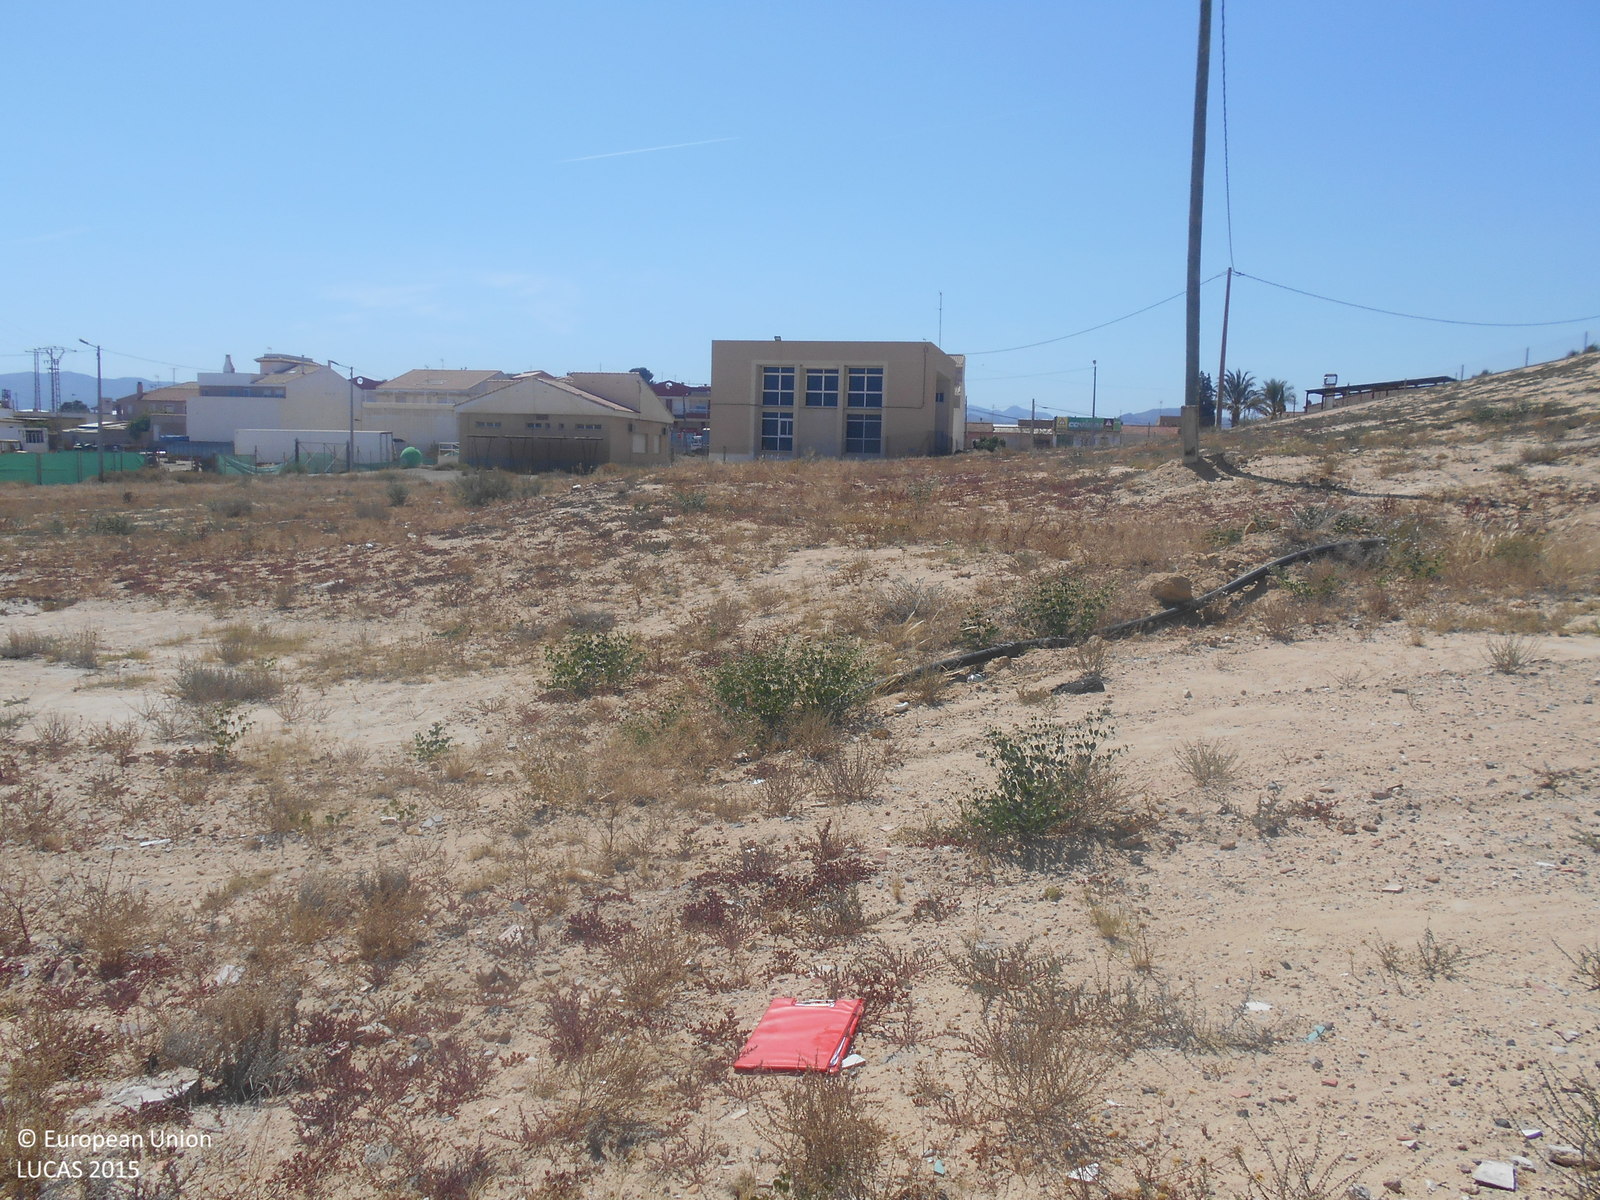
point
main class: Grassland
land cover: Spontaneously vegetated surfaces
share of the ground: 25 - 50 %
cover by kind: unconsolidated bare surface 60 %, herbaceous plants 35 %, shrubs 5 %
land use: Abandoned areas
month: May
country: ES
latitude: 37.5562
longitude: -1.3788
